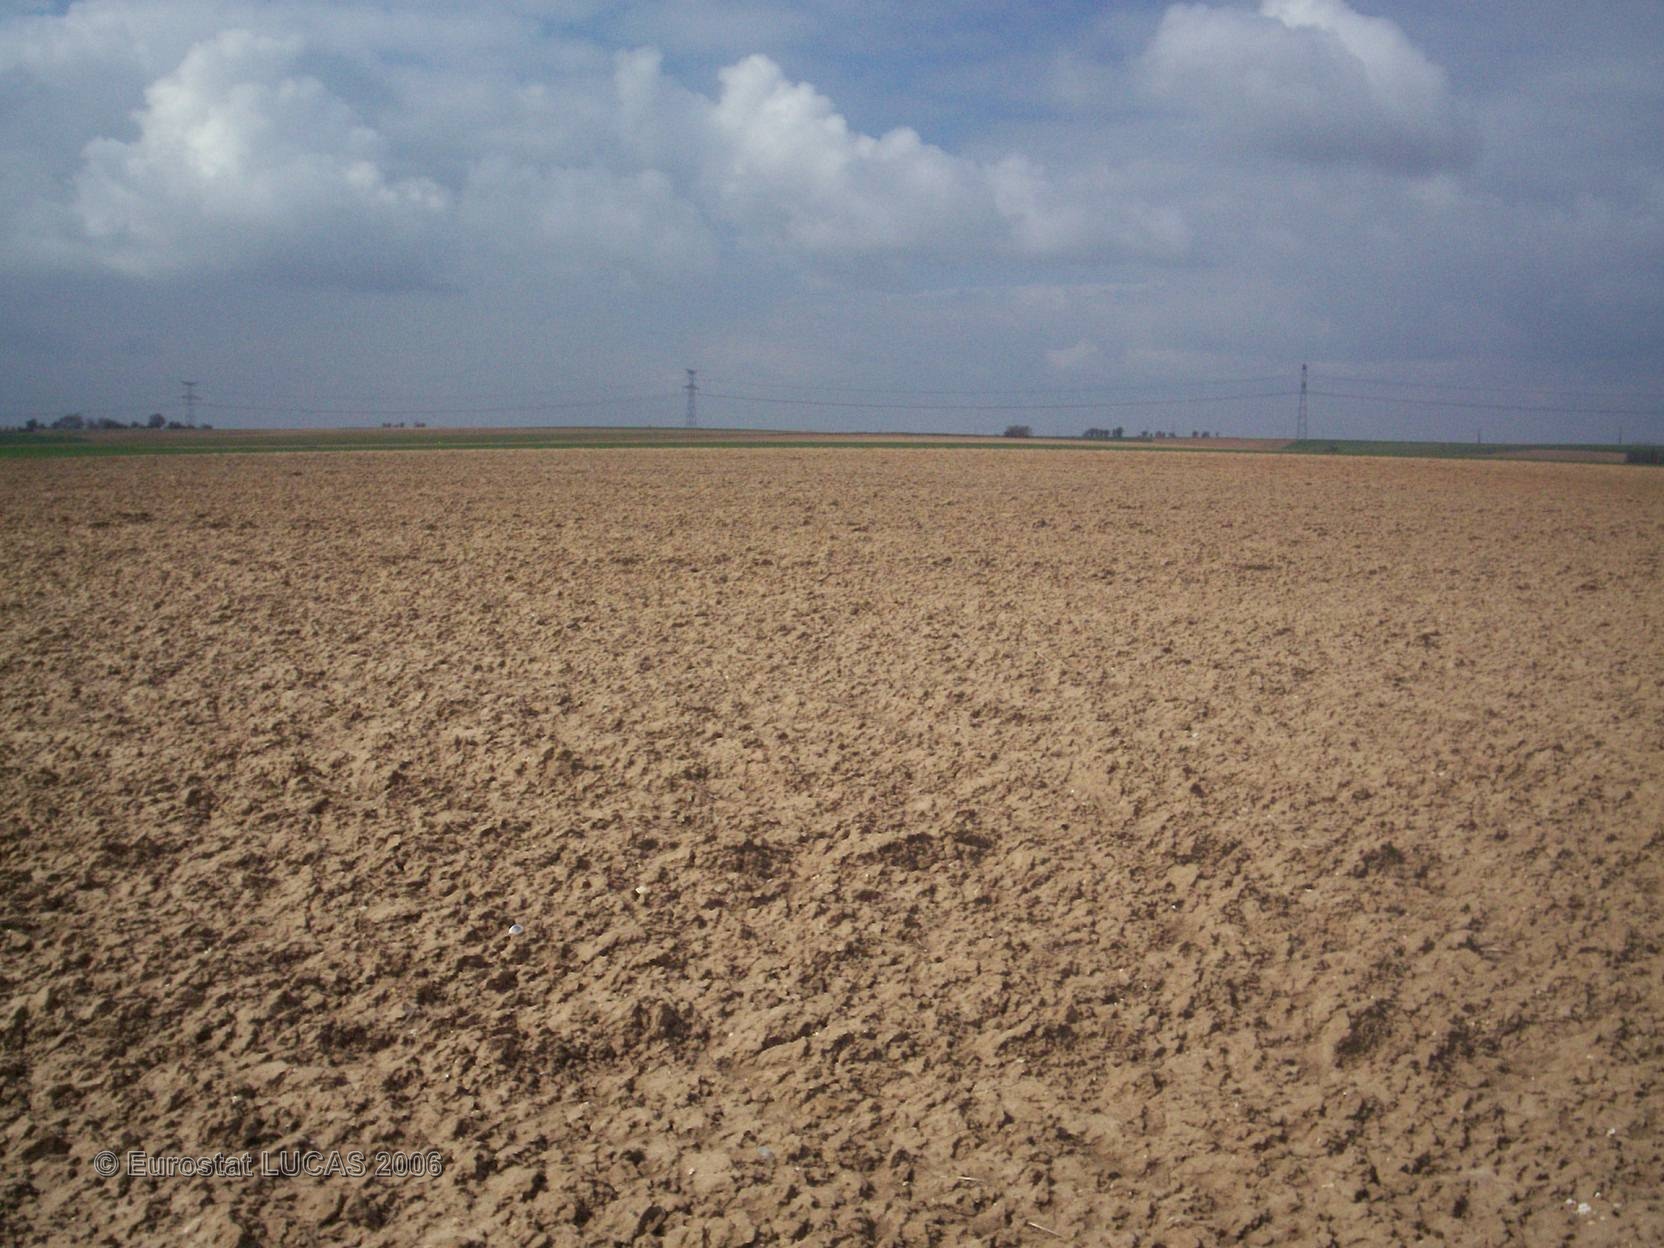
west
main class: Cropland
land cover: Potatoes
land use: Agriculture (excluding fallow land and kitchen gardens)
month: June
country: FR
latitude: 50.0877
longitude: 2.5944
